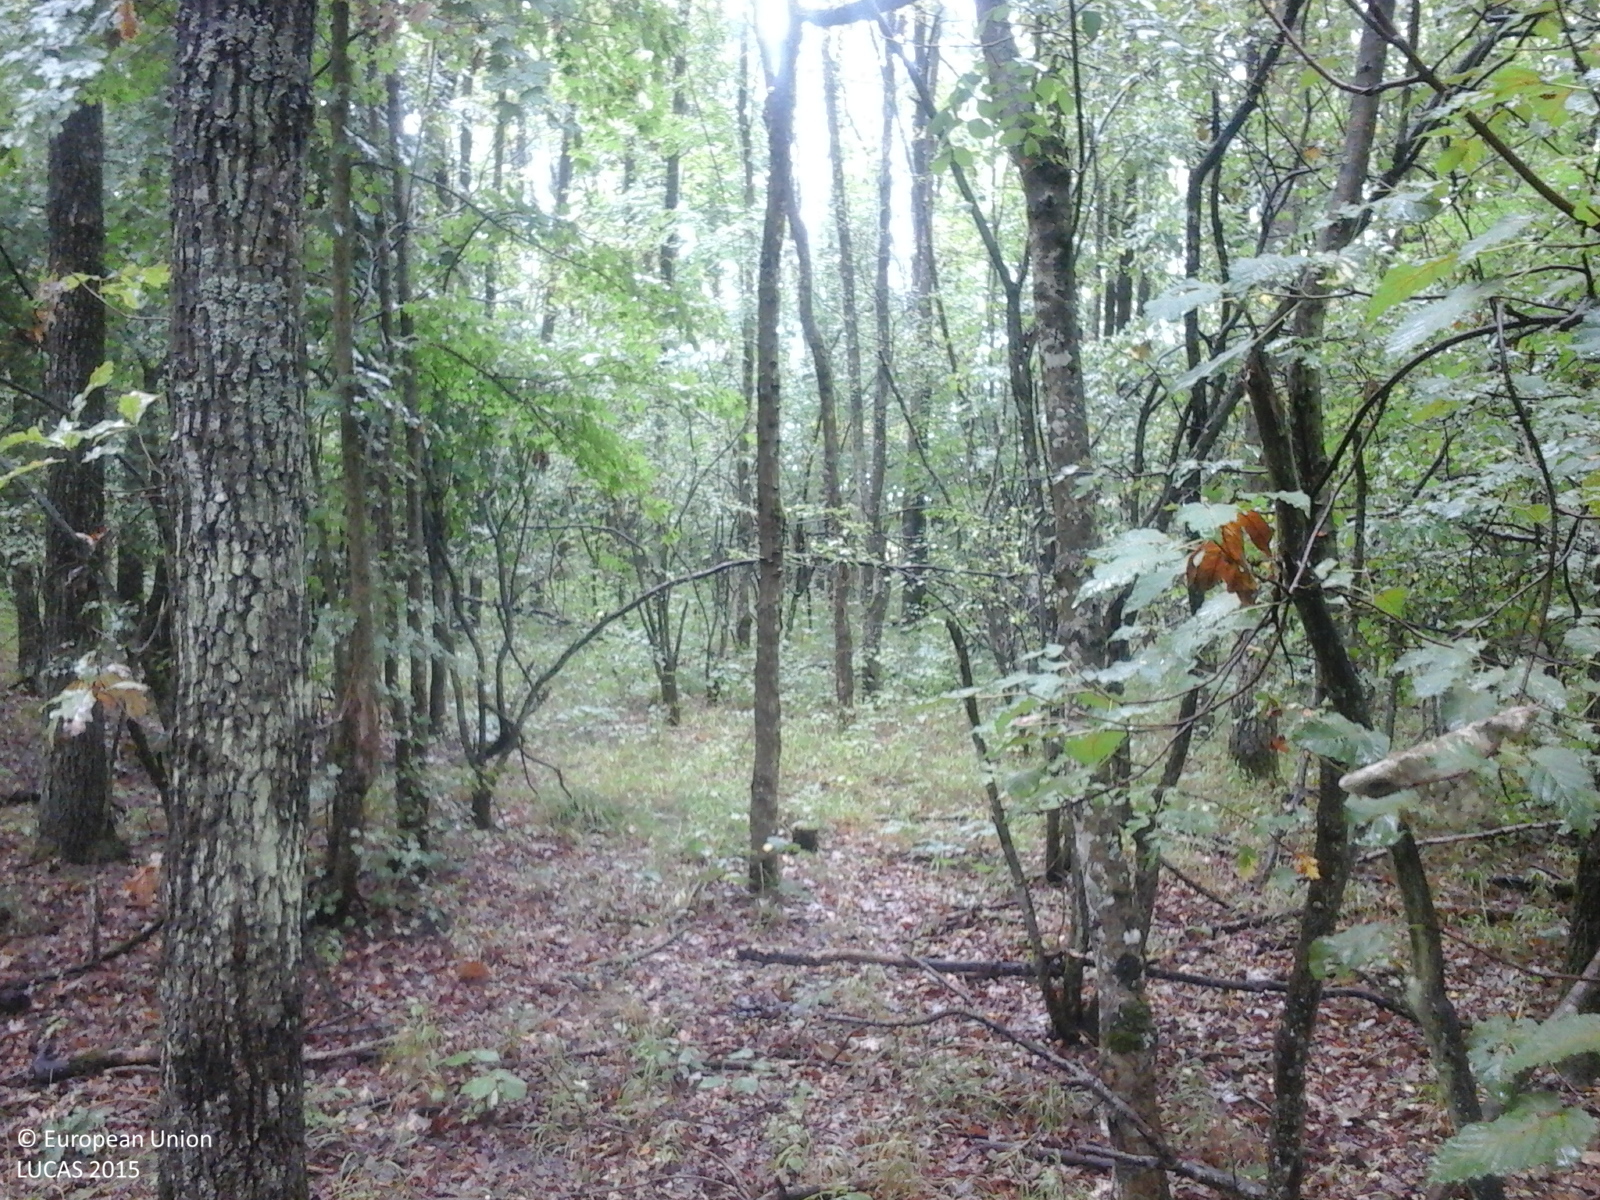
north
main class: Woodland
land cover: Broadleaved woodland
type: acidophilous oak and oak-birch forest
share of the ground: > 75 %
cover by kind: broadleaved forest trees 100 %
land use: Forestry
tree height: > 5 m
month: August
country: RO
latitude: 45.7128
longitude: 21.4792
